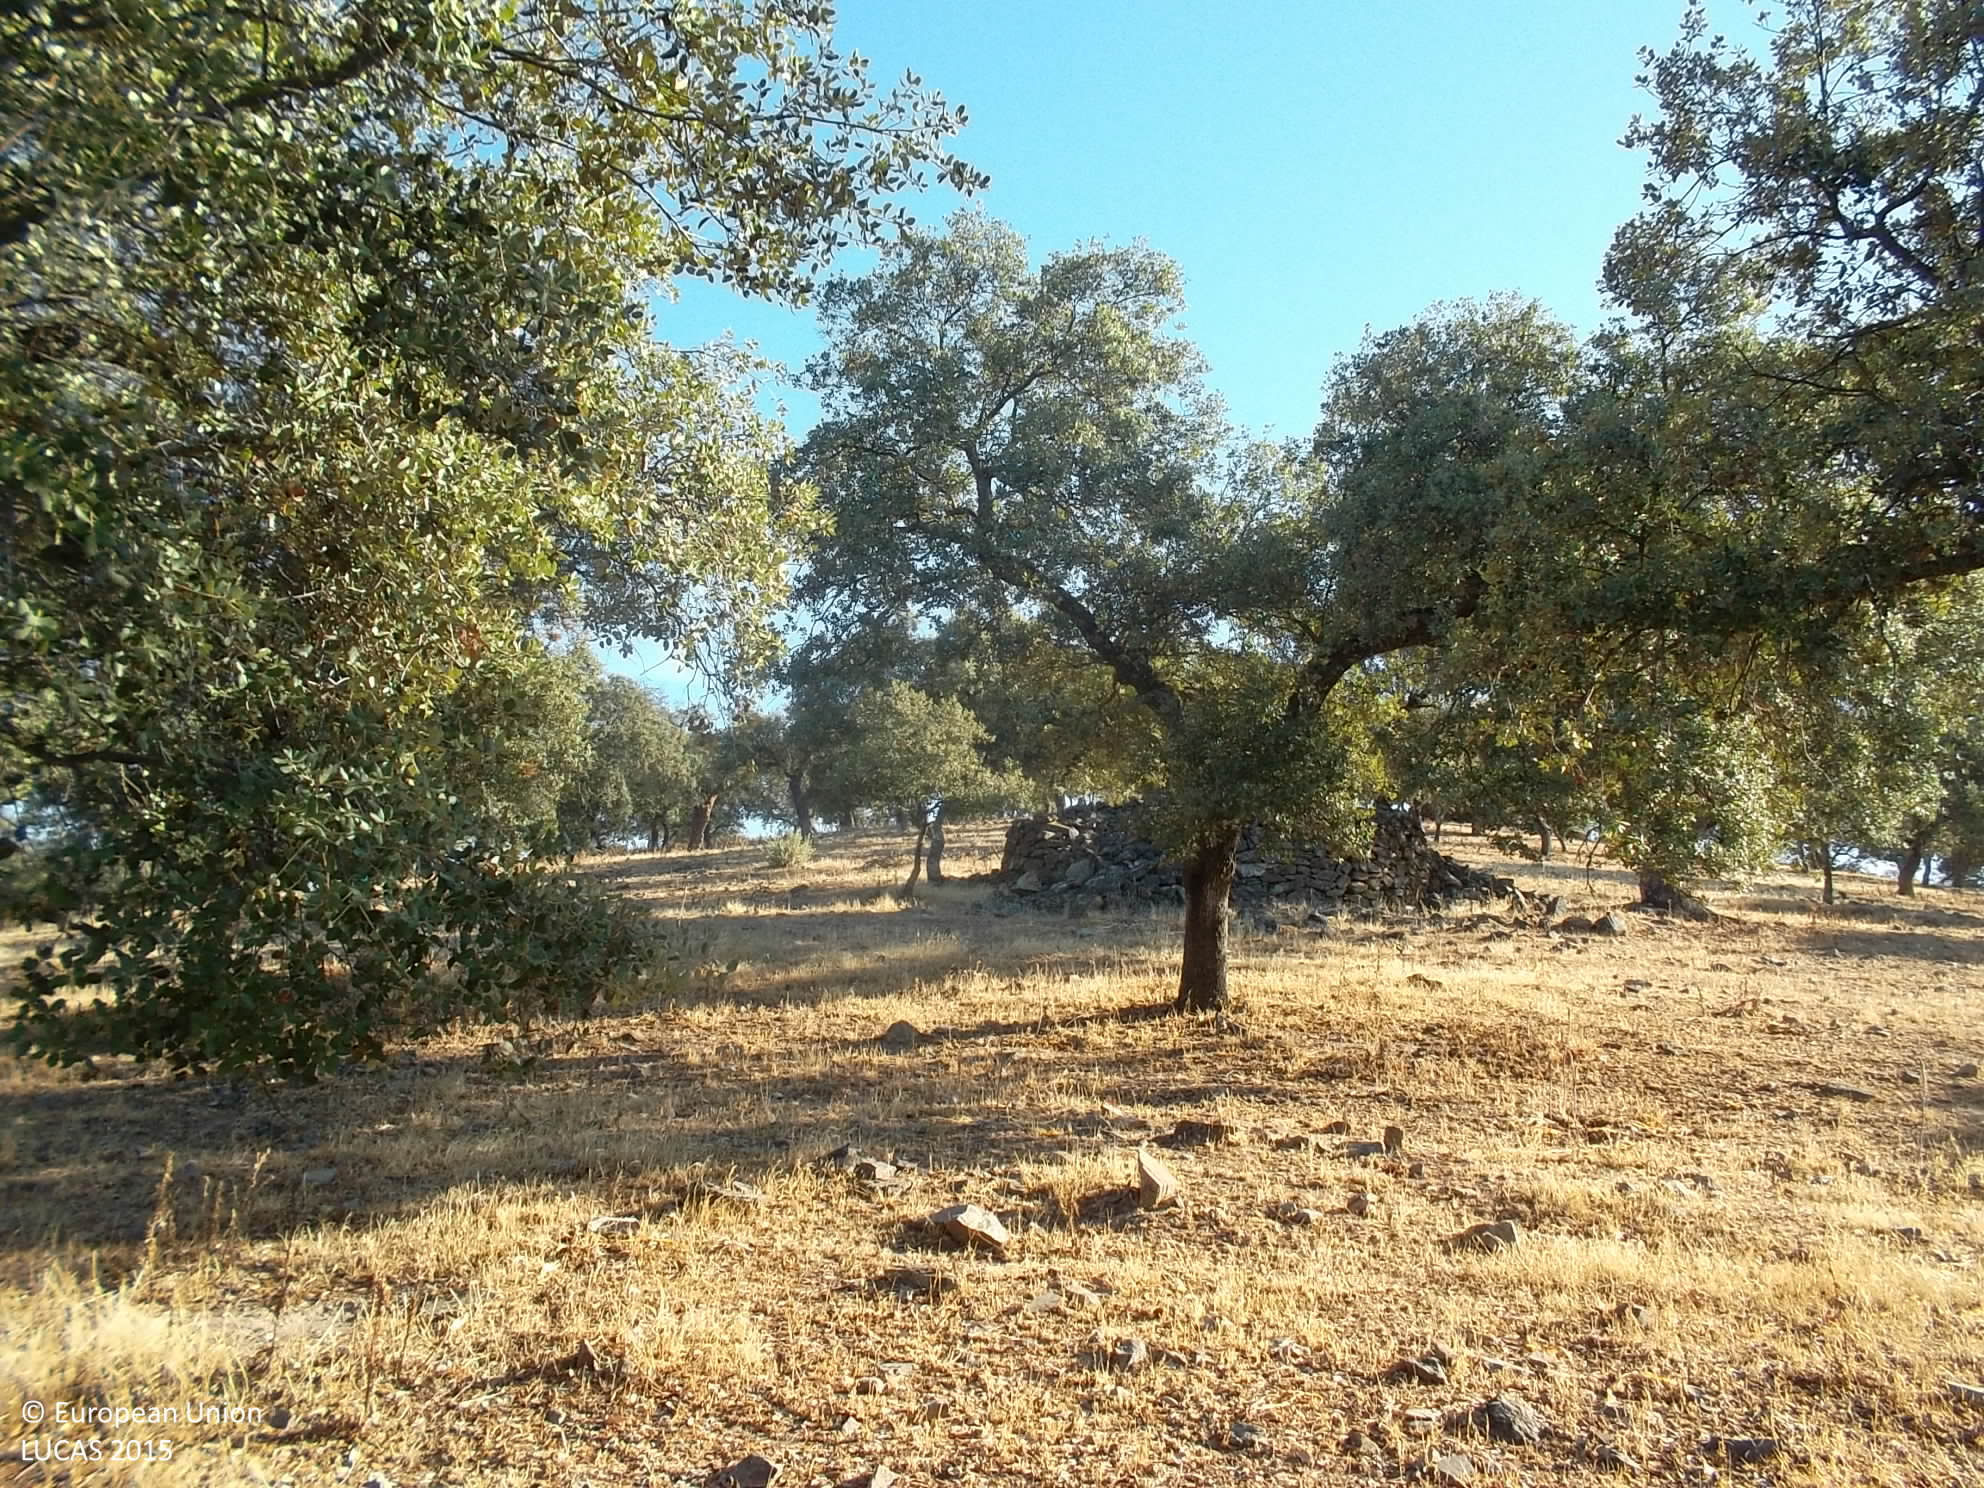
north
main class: Woodland
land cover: Broadleaved woodland
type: broadleaved evergreen forest
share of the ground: 50 - 75 %
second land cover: Grassland without tree/shrub cover
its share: > 75 %
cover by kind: broadleaved forest trees 50 %, herbaceous plants 50 %
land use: Forestry
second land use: Agriculture (excluding fallow land and kitchen gardens)
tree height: < 5 m
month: August
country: ES
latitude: 38.4919
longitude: -6.5992
